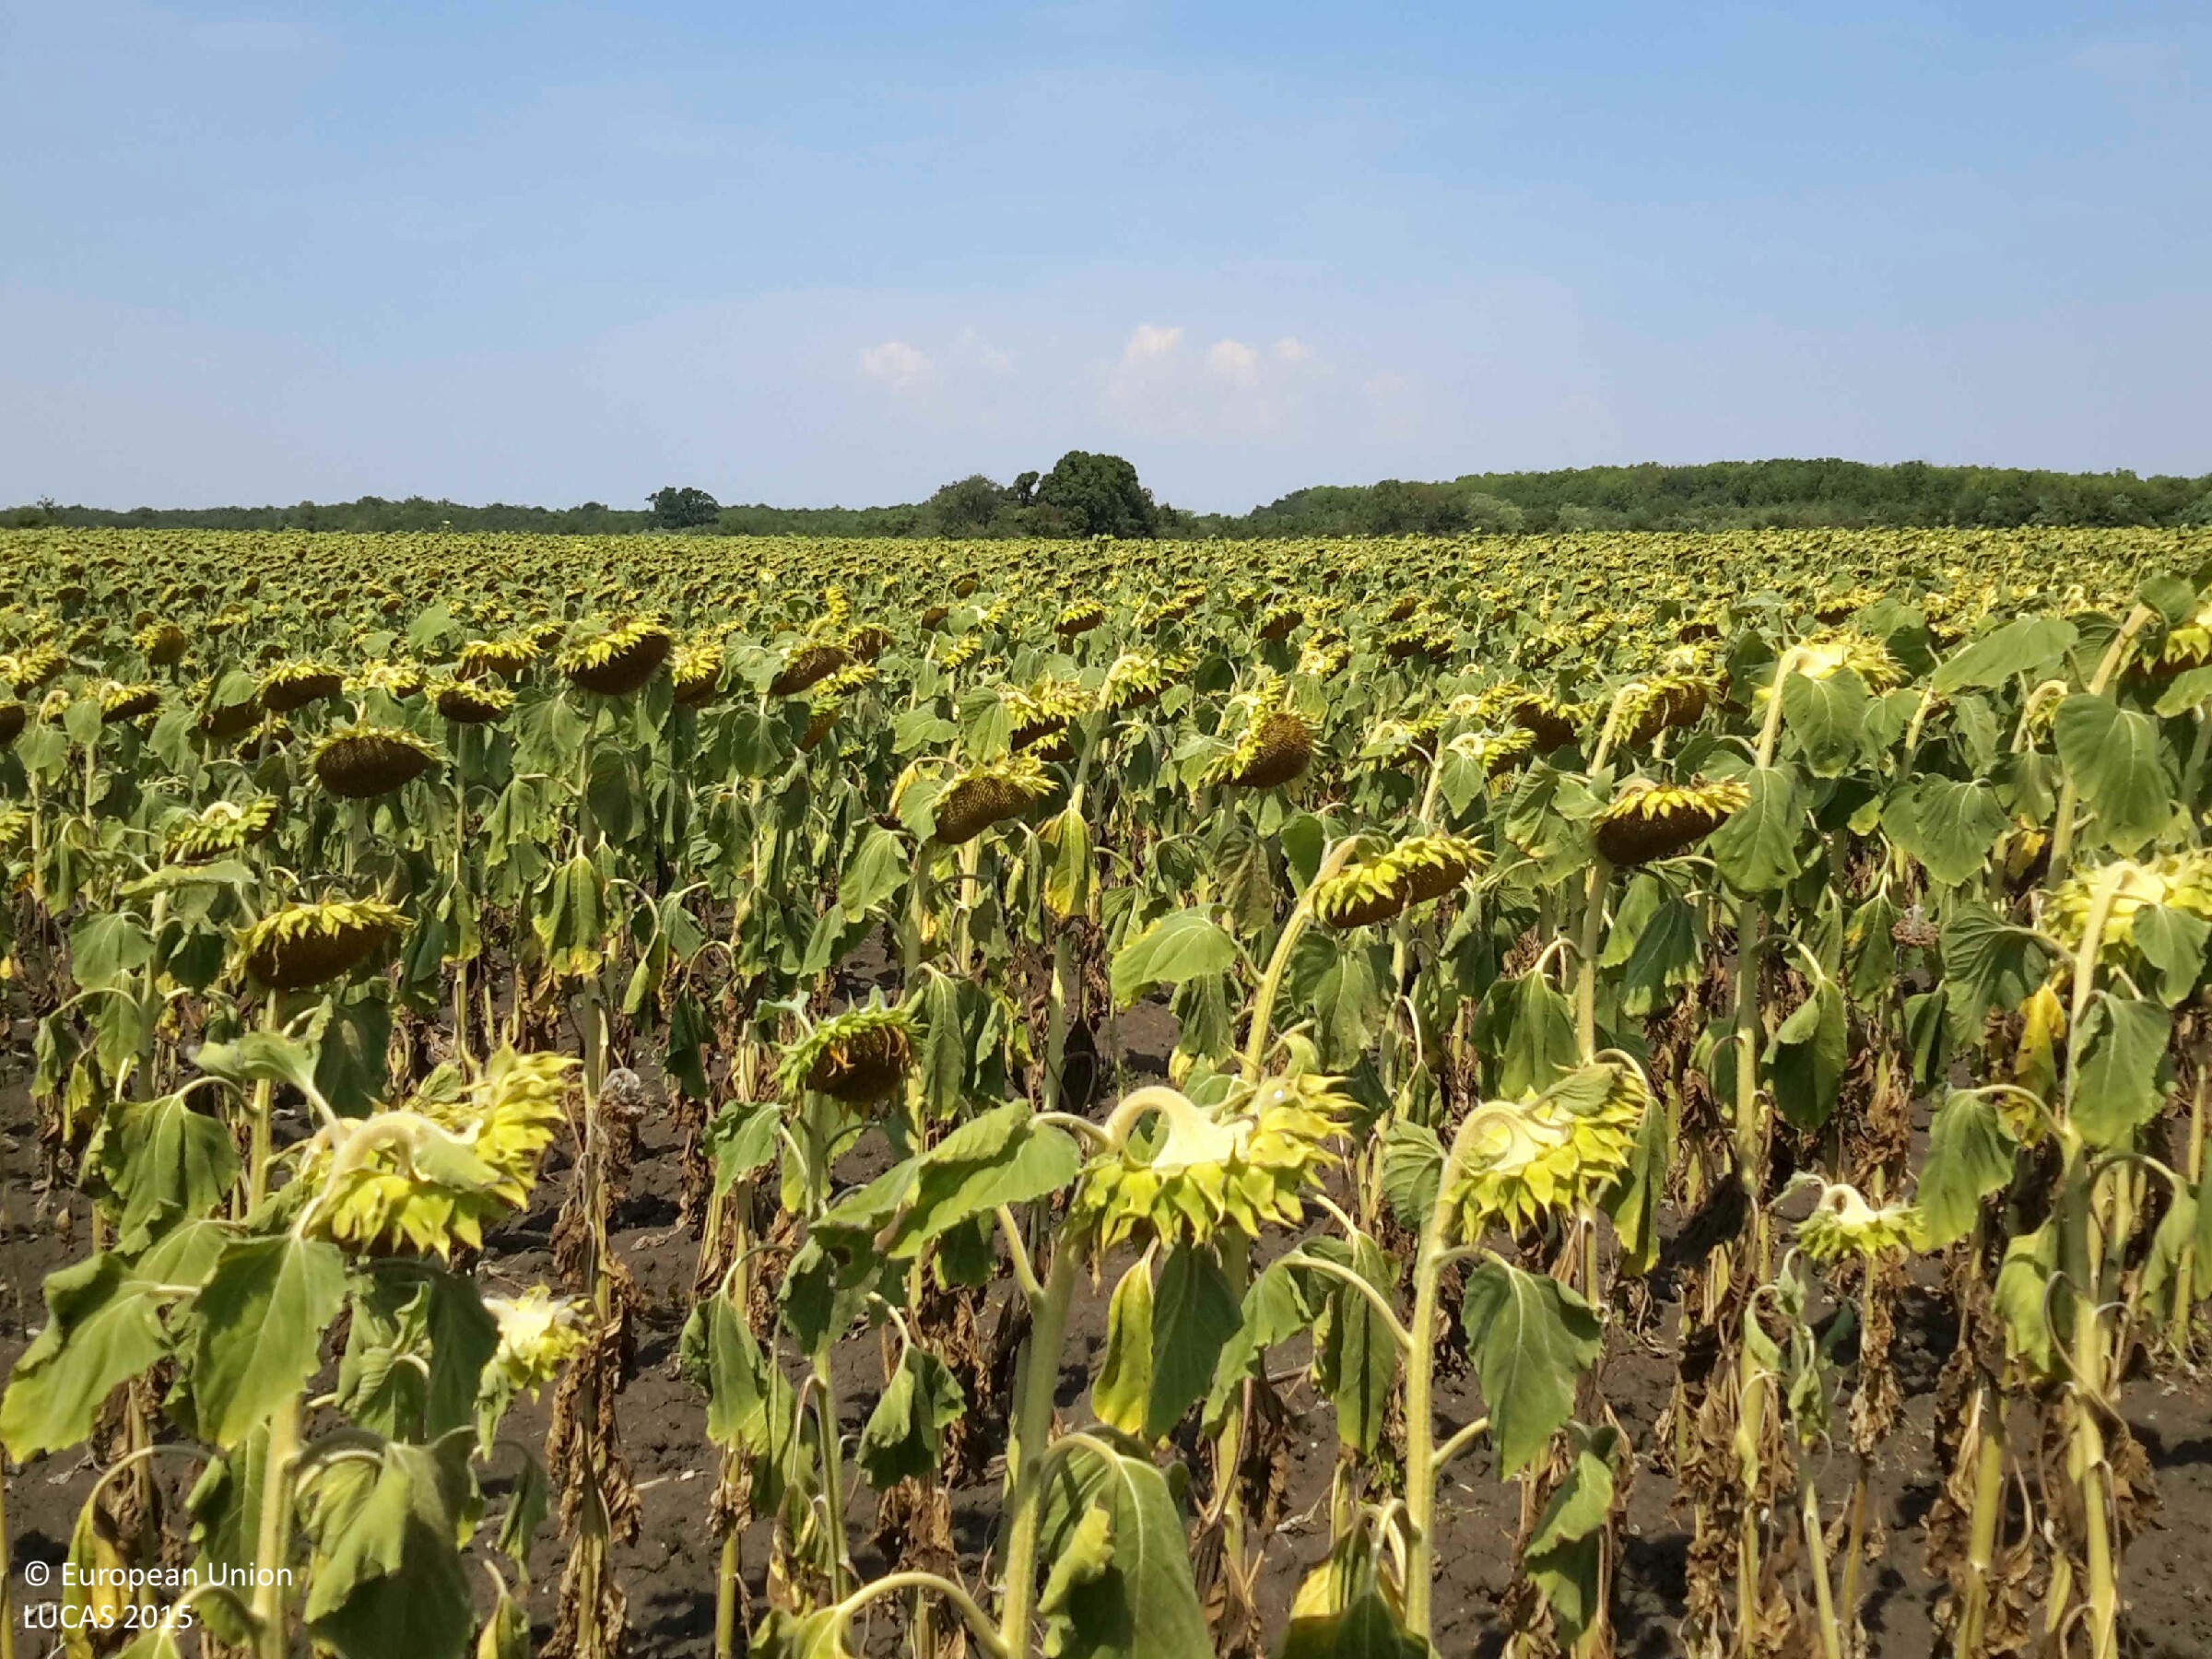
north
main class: Cropland
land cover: Sunflower
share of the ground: > 75 %
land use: Agriculture (excluding fallow land and kitchen gardens)
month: August
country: HU
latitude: 47.8948
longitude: 17.2441
